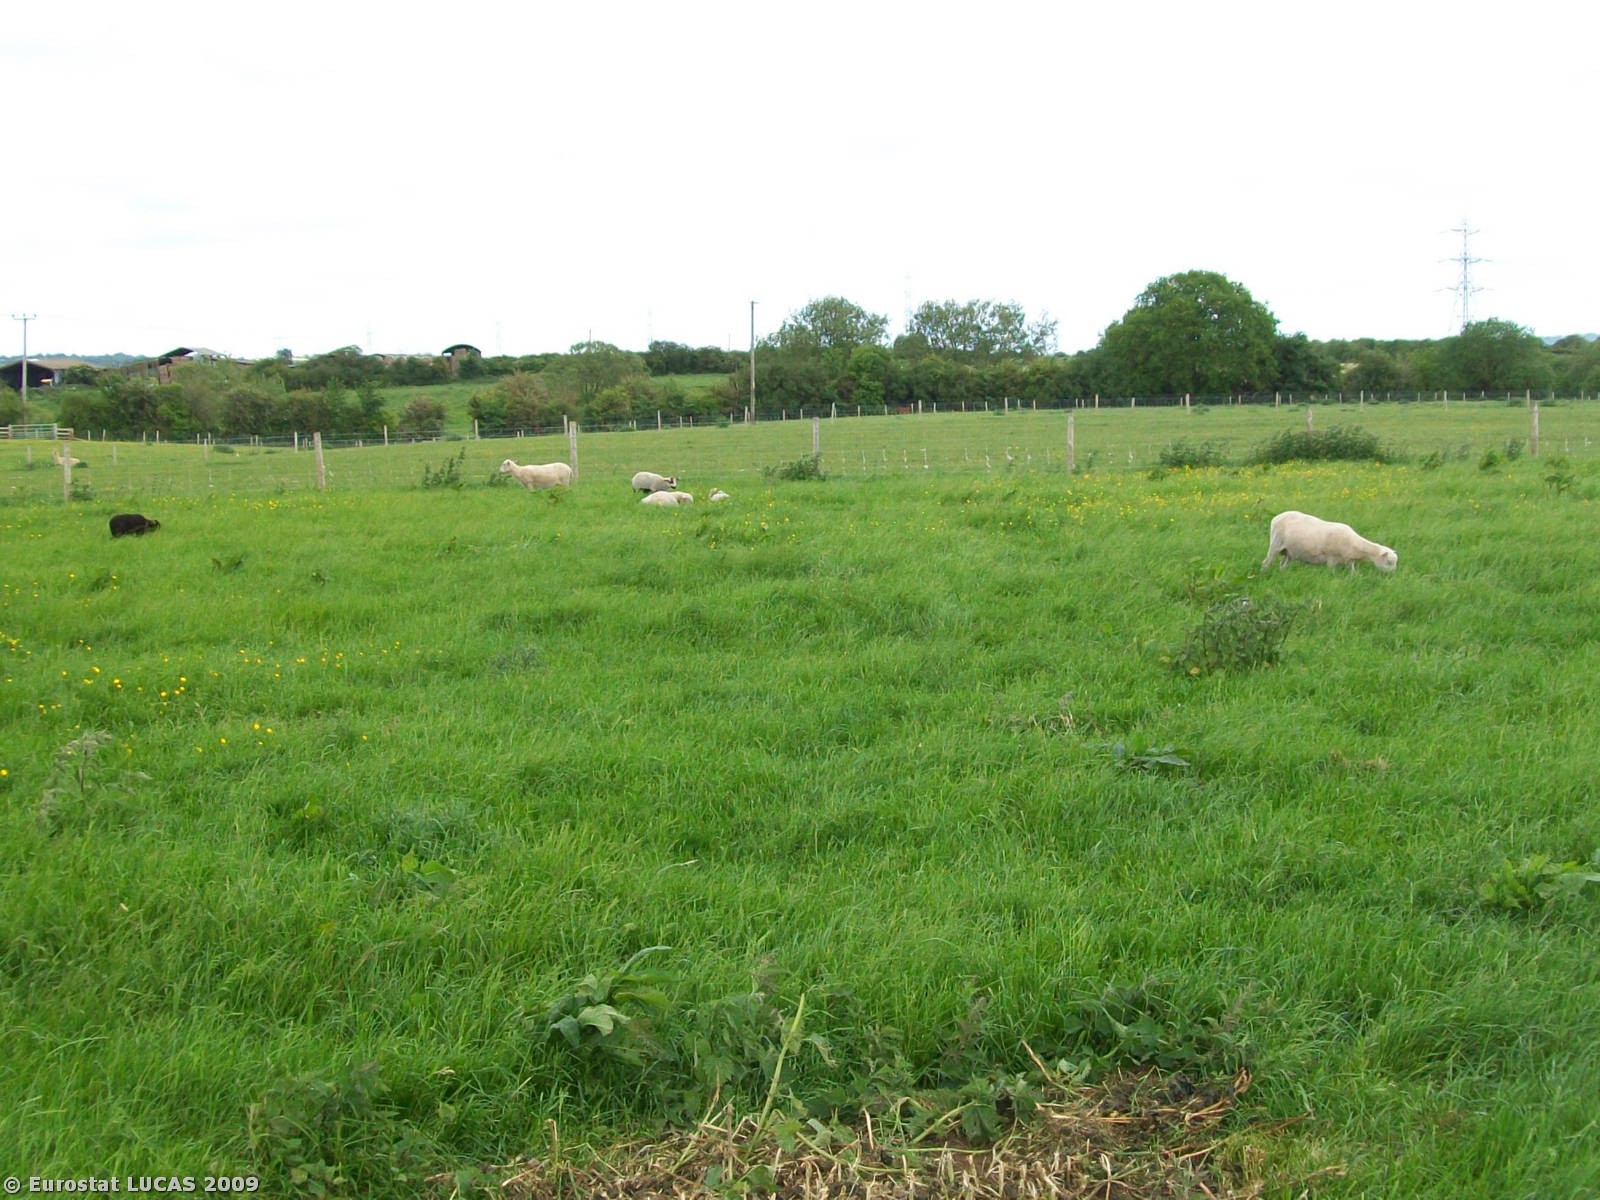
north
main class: Grassland
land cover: Grassland without tree/shrub cover
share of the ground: > 75 %
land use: Agriculture (excluding fallow land and kitchen gardens)
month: May
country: GB
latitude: 51.3488
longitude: -2.1648
